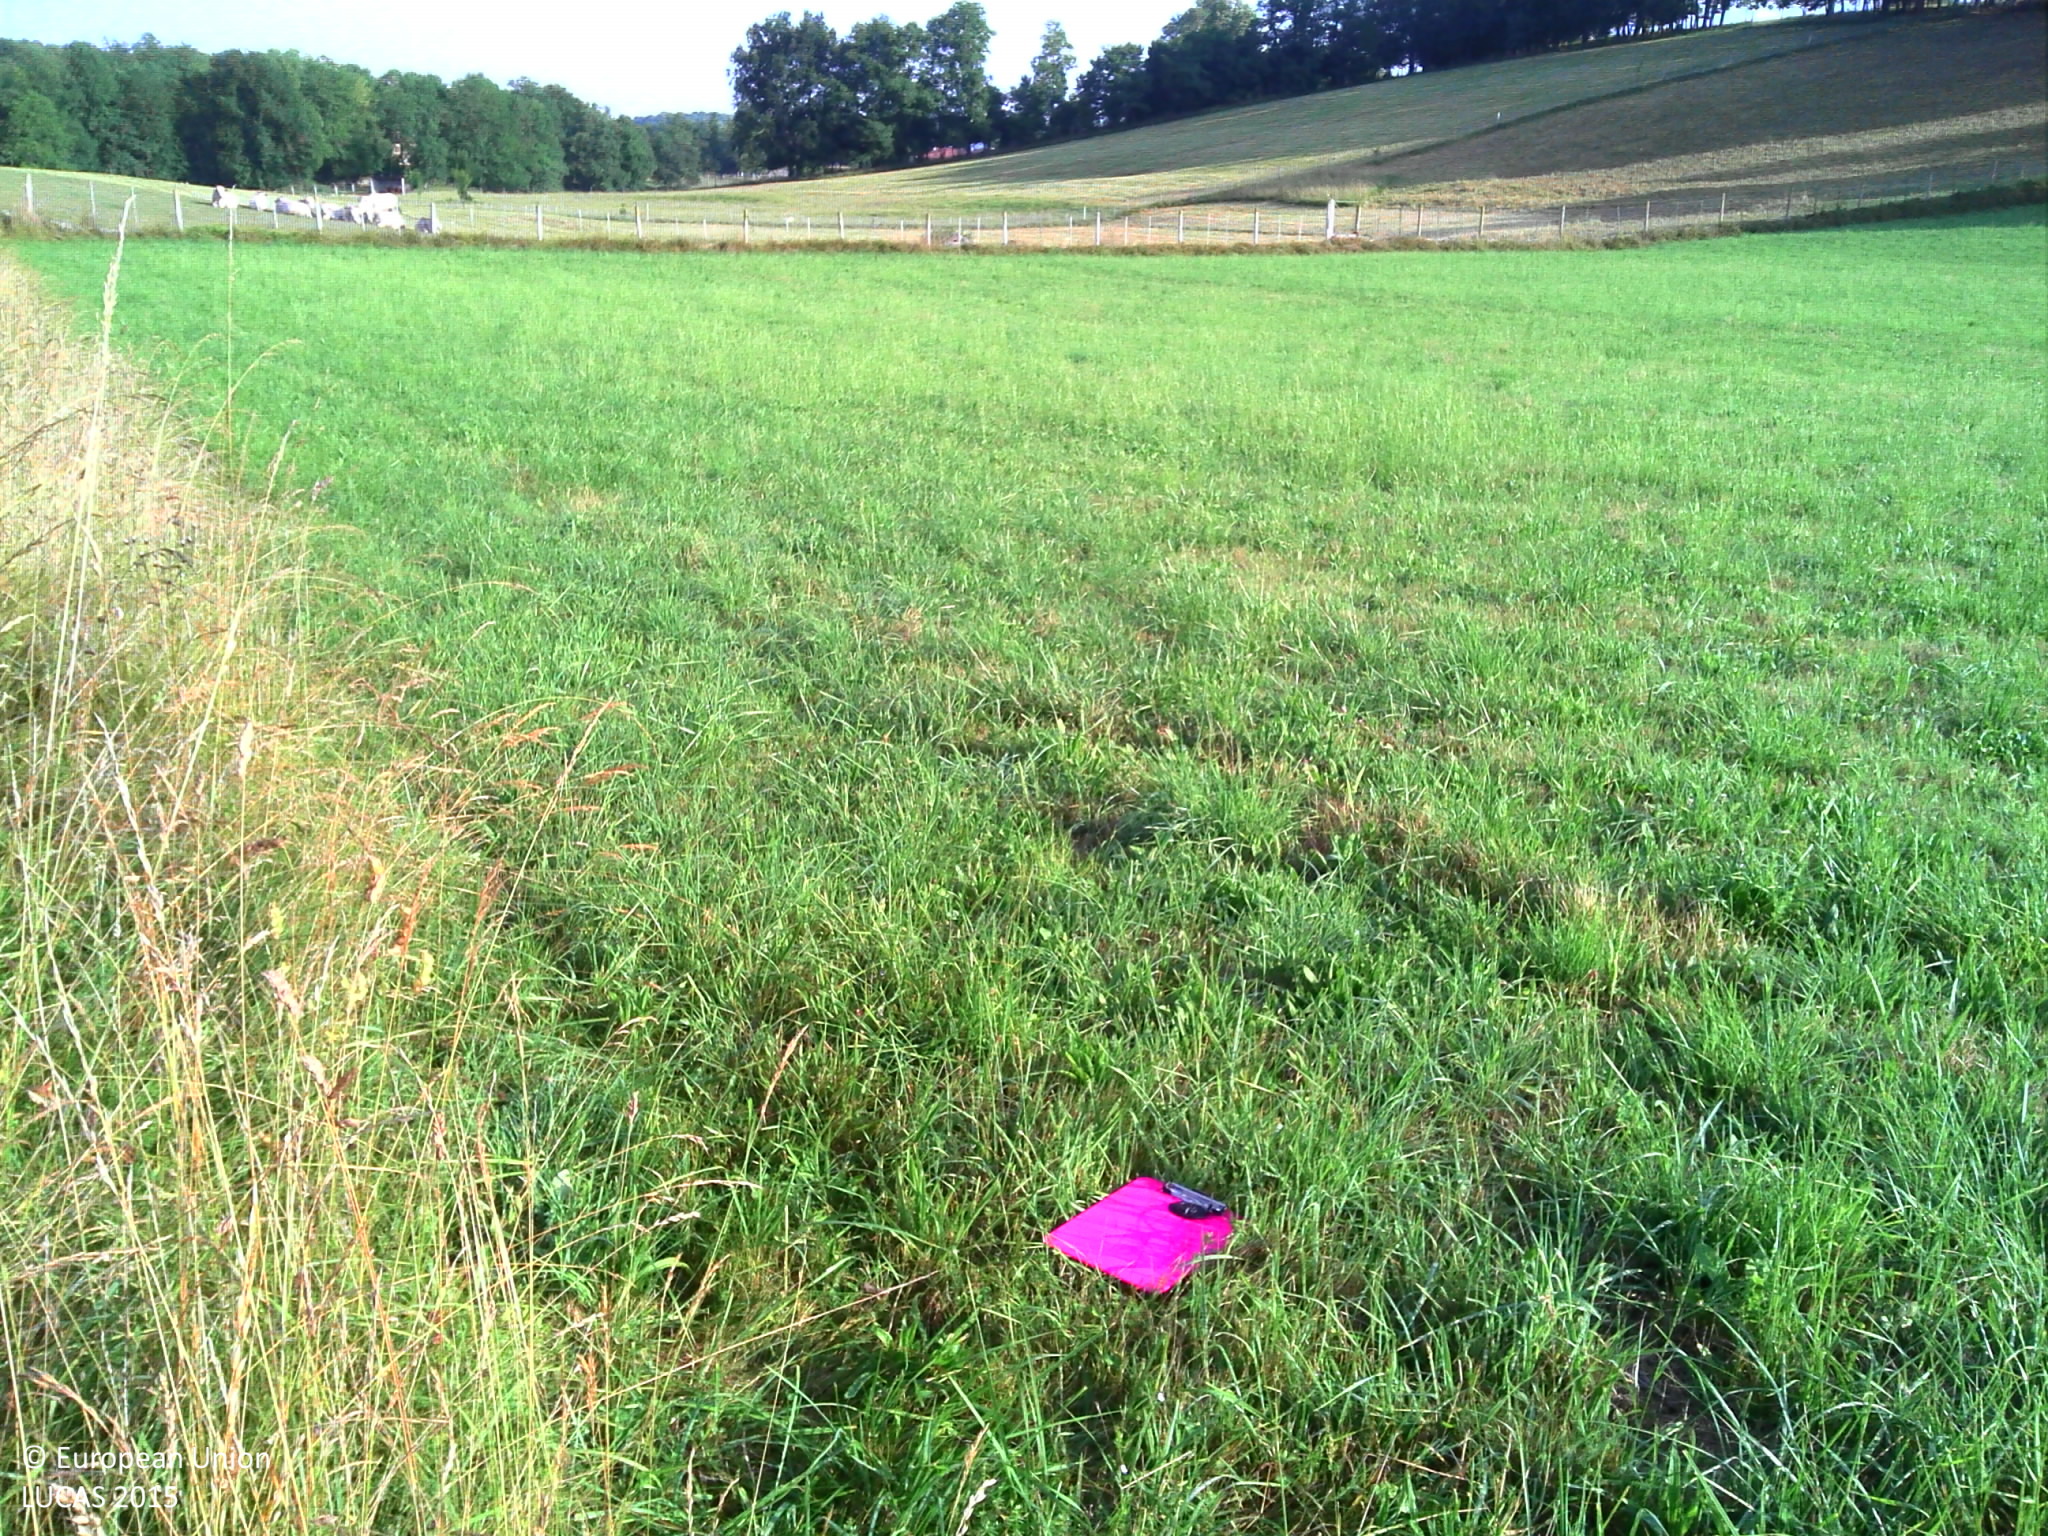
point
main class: Grassland
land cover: Grassland without tree/shrub cover
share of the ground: > 75 %
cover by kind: herbaceous plants 100 %
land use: Agriculture (excluding fallow land and kitchen gardens)
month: July
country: FR
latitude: 42.9731
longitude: 1.1399
